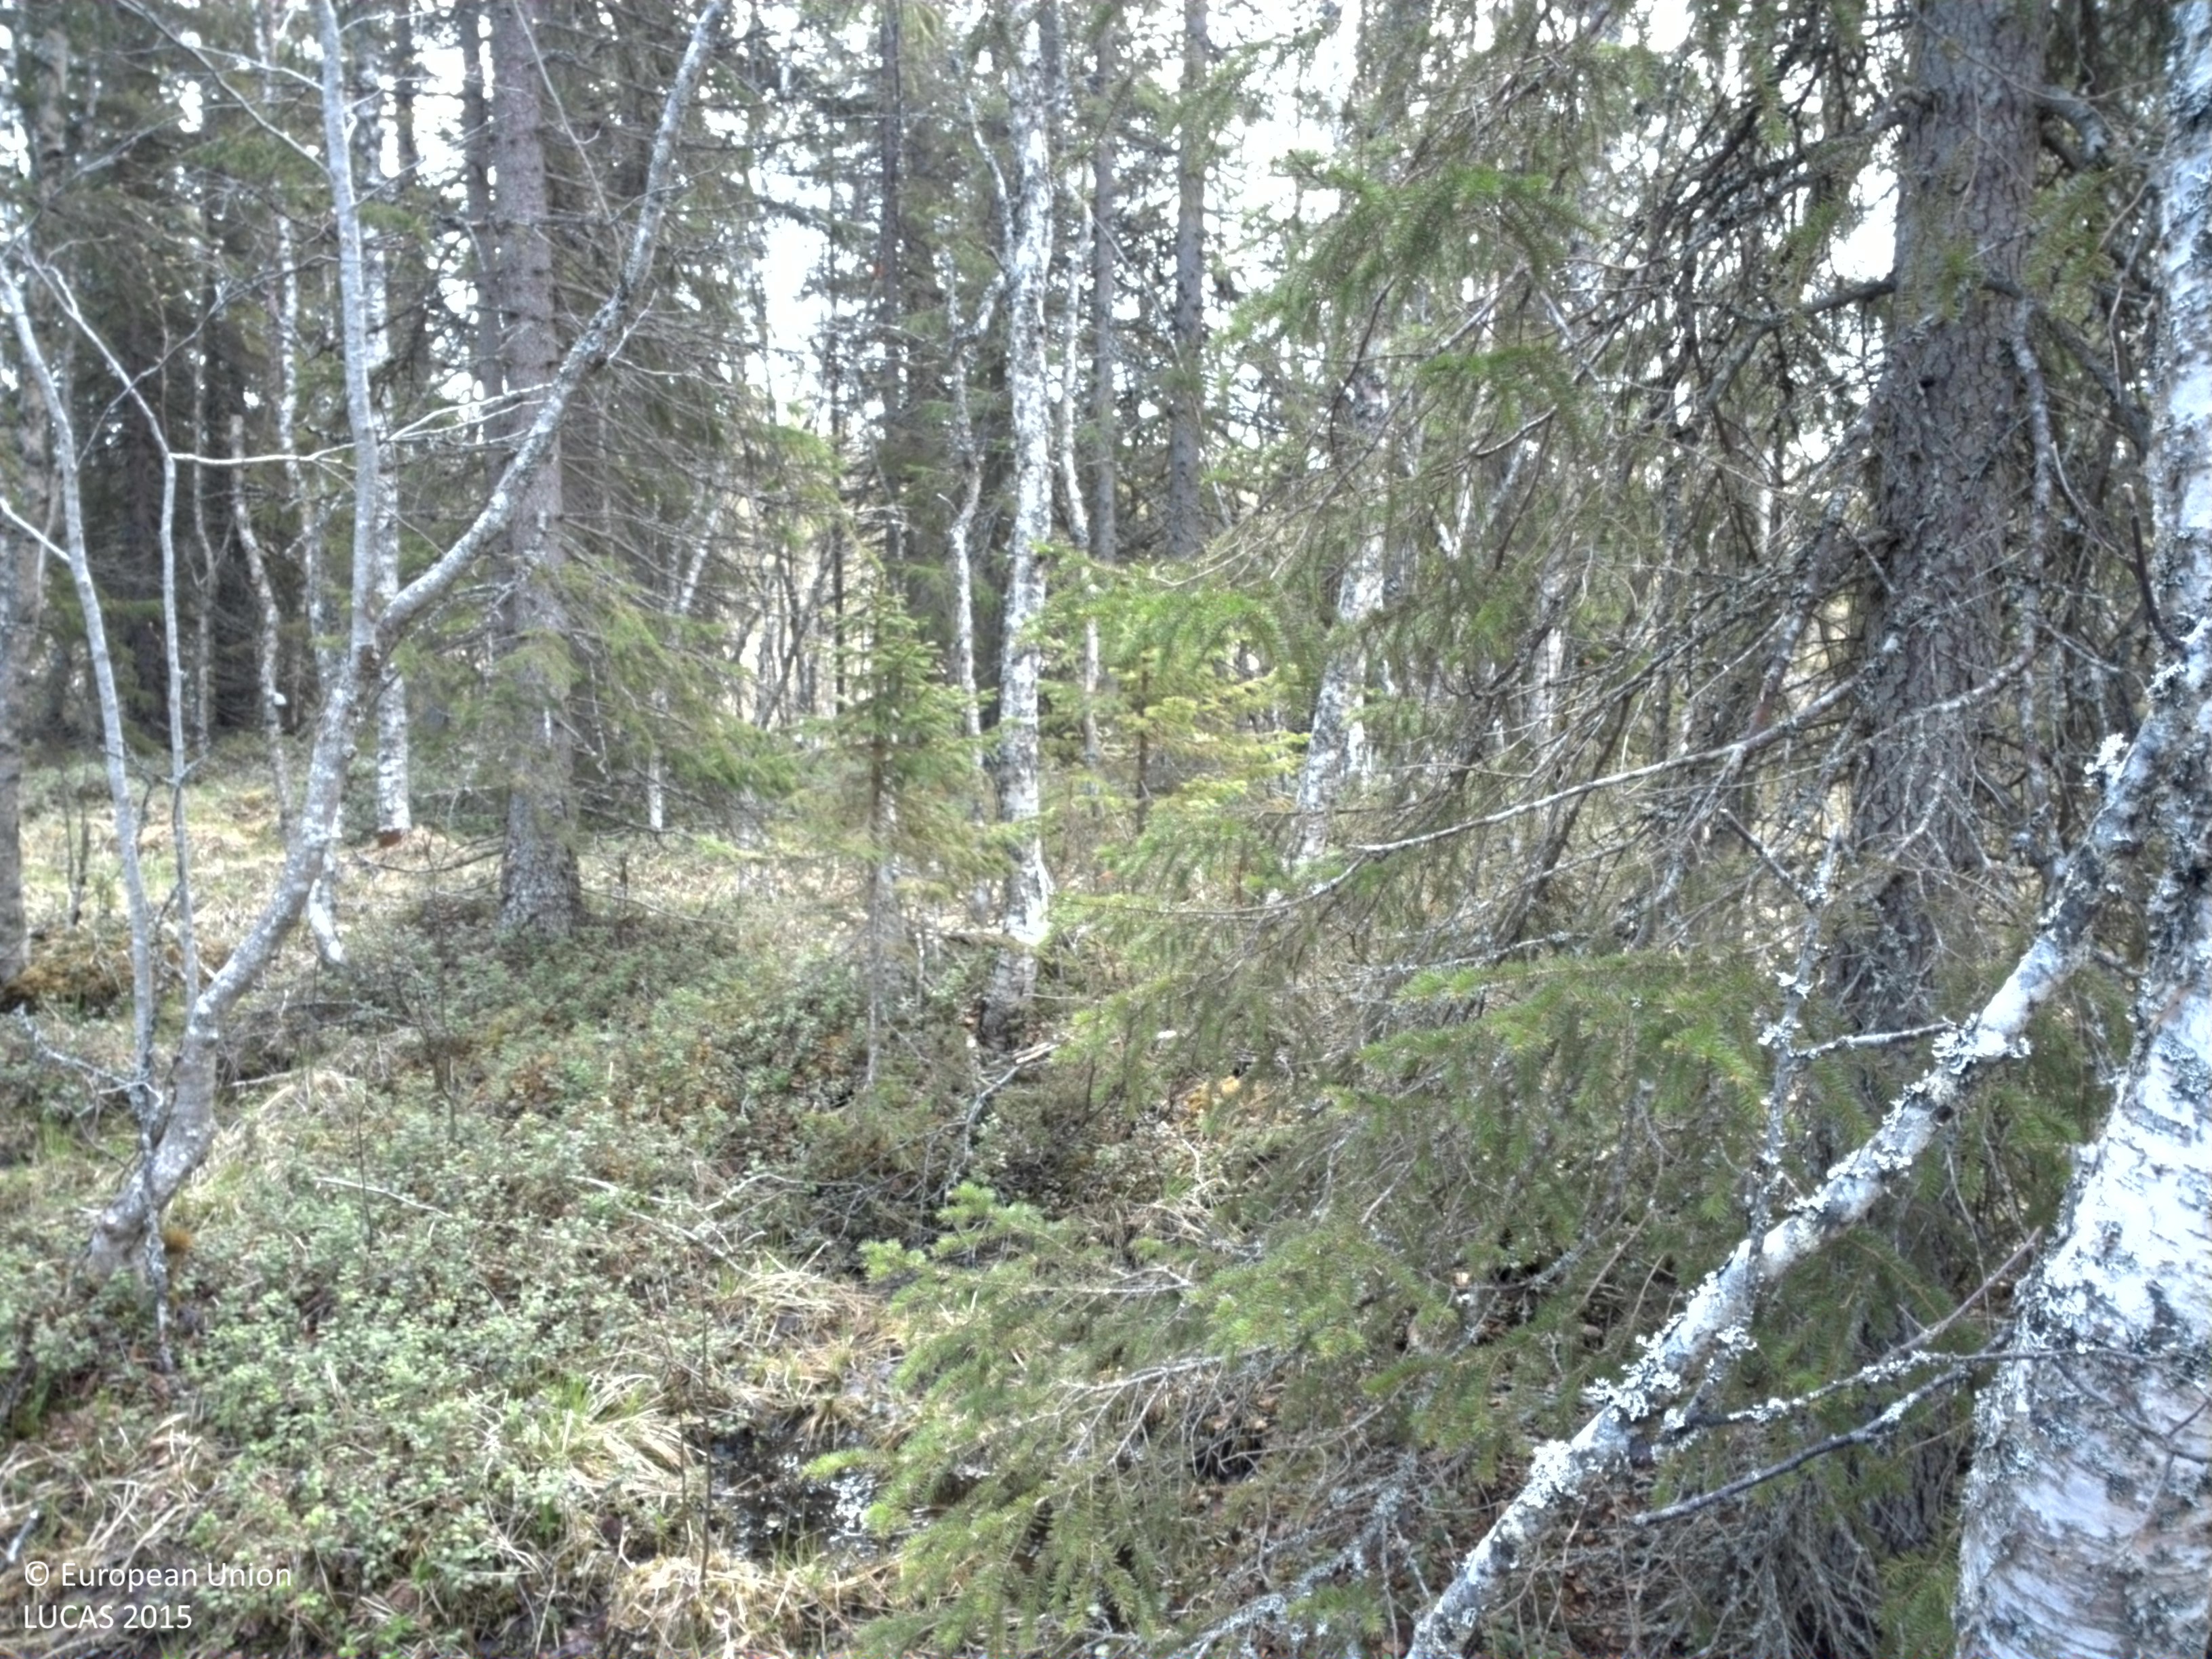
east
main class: Woodland
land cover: Spruce dominated mixed woodland
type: boreal forest
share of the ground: > 75 %
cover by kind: coniferous forest trees 65 %, broadleaved forest trees 25 %, shrubs 10 %
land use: Forestry
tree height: > 5 m
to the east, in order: Spruce dominated mixed woodland; Broadleaved woodland; Inland marshes; Spruce dominated mixed woodland; Ditches and canals; Spruce dominated mixed woodland
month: June
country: SE
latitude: 63.5218
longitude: 13.7799
